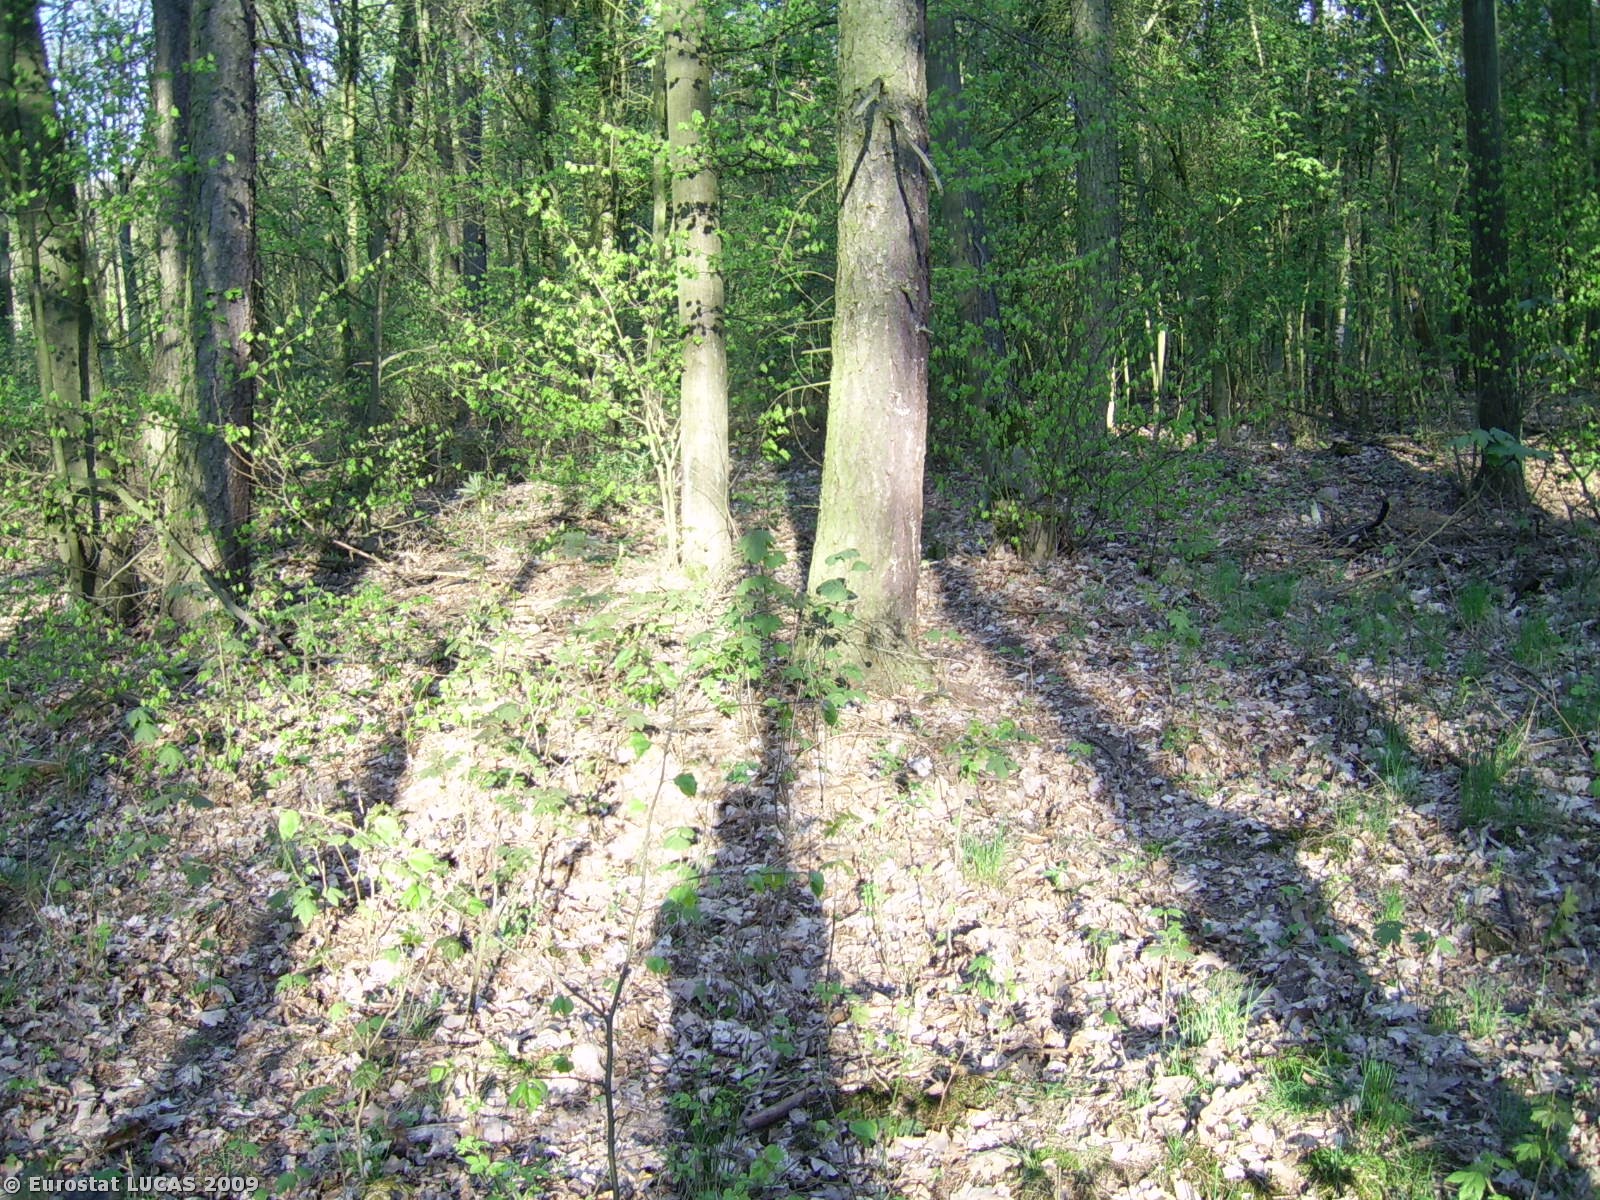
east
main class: Woodland
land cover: Mixed woodland
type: hemiboreal forest and nemoral coniferous forest and mixed broadleaved-coniferous forest
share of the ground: > 75 %
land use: Forestry
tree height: > 5 m
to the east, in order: Mixed woodland; Tracks; Mixed woodland
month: April
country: PL
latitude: 52.2662
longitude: 16.9110
